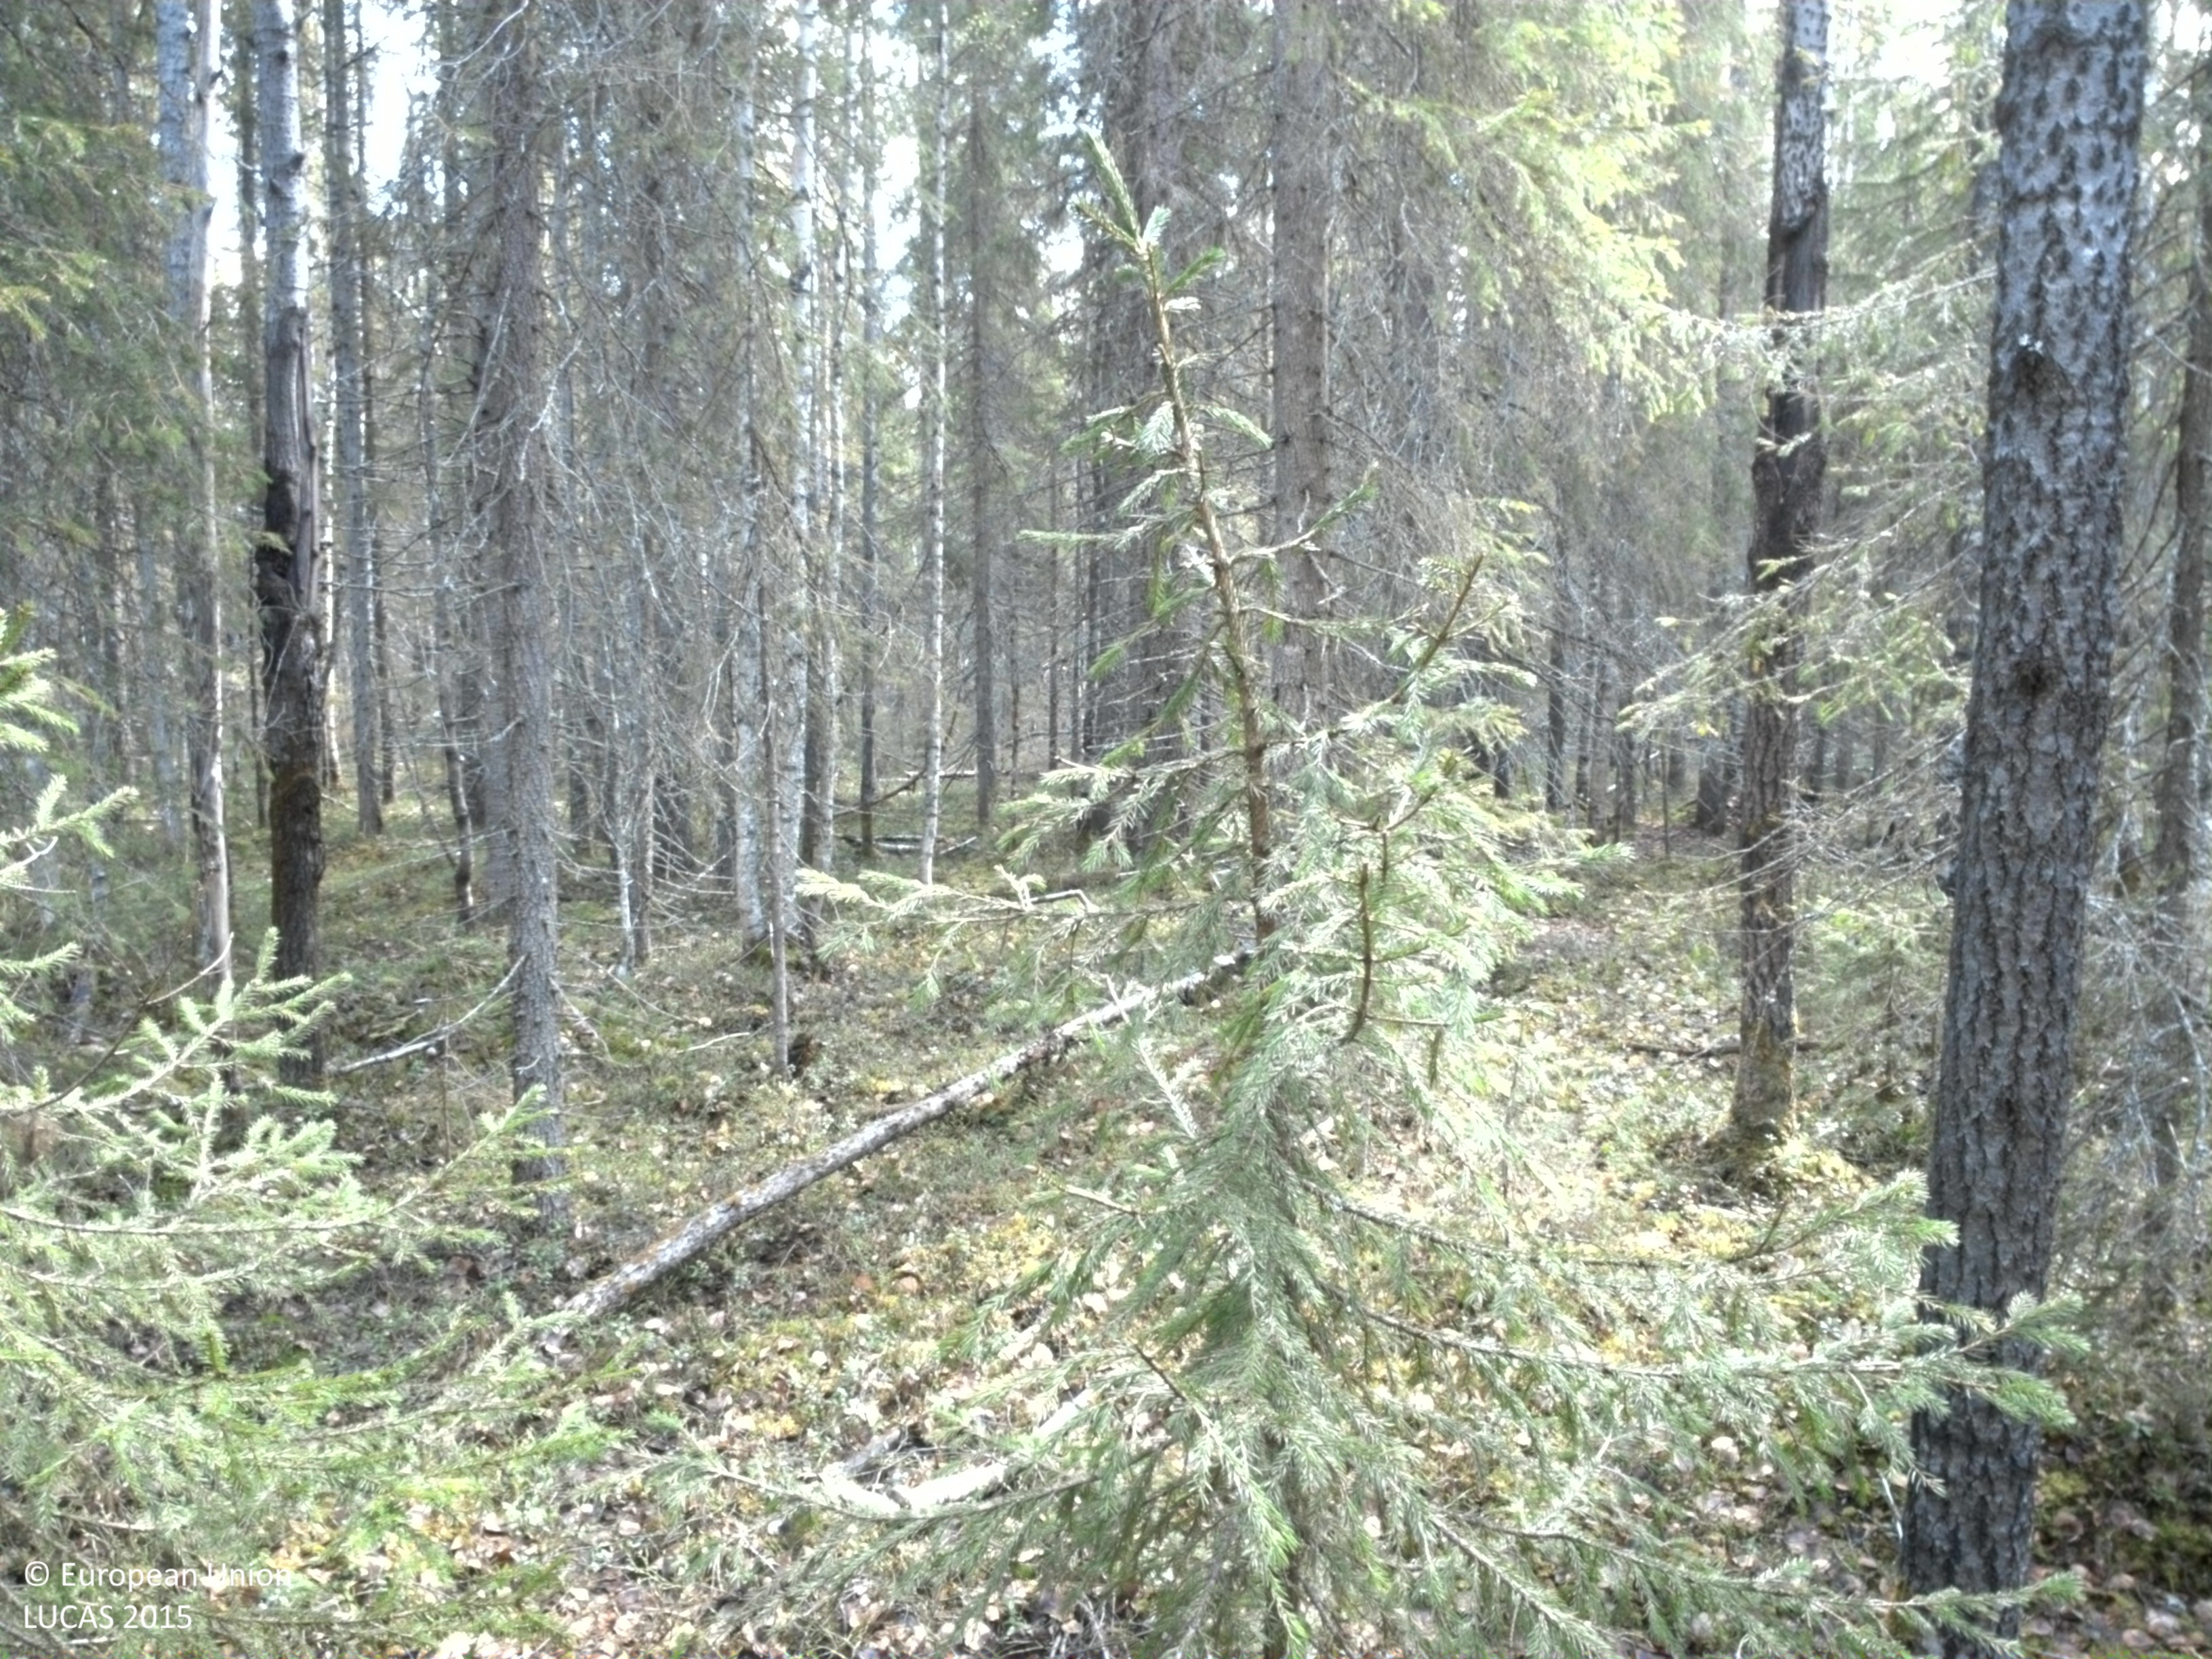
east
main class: Woodland
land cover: Spruce dominated coniferous woodland
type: boreal forest
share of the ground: > 75 %
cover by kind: coniferous forest trees 85 %, shrubs 10 %, broadleaved forest trees 5 %
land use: Forestry
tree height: > 5 m
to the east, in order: Spruce dominated coniferous woodland; Ditches and canals; Spruce dominated coniferous woodland; Spruce dominated mixed woodland
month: May
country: SE
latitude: 66.1410
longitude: 23.2120
